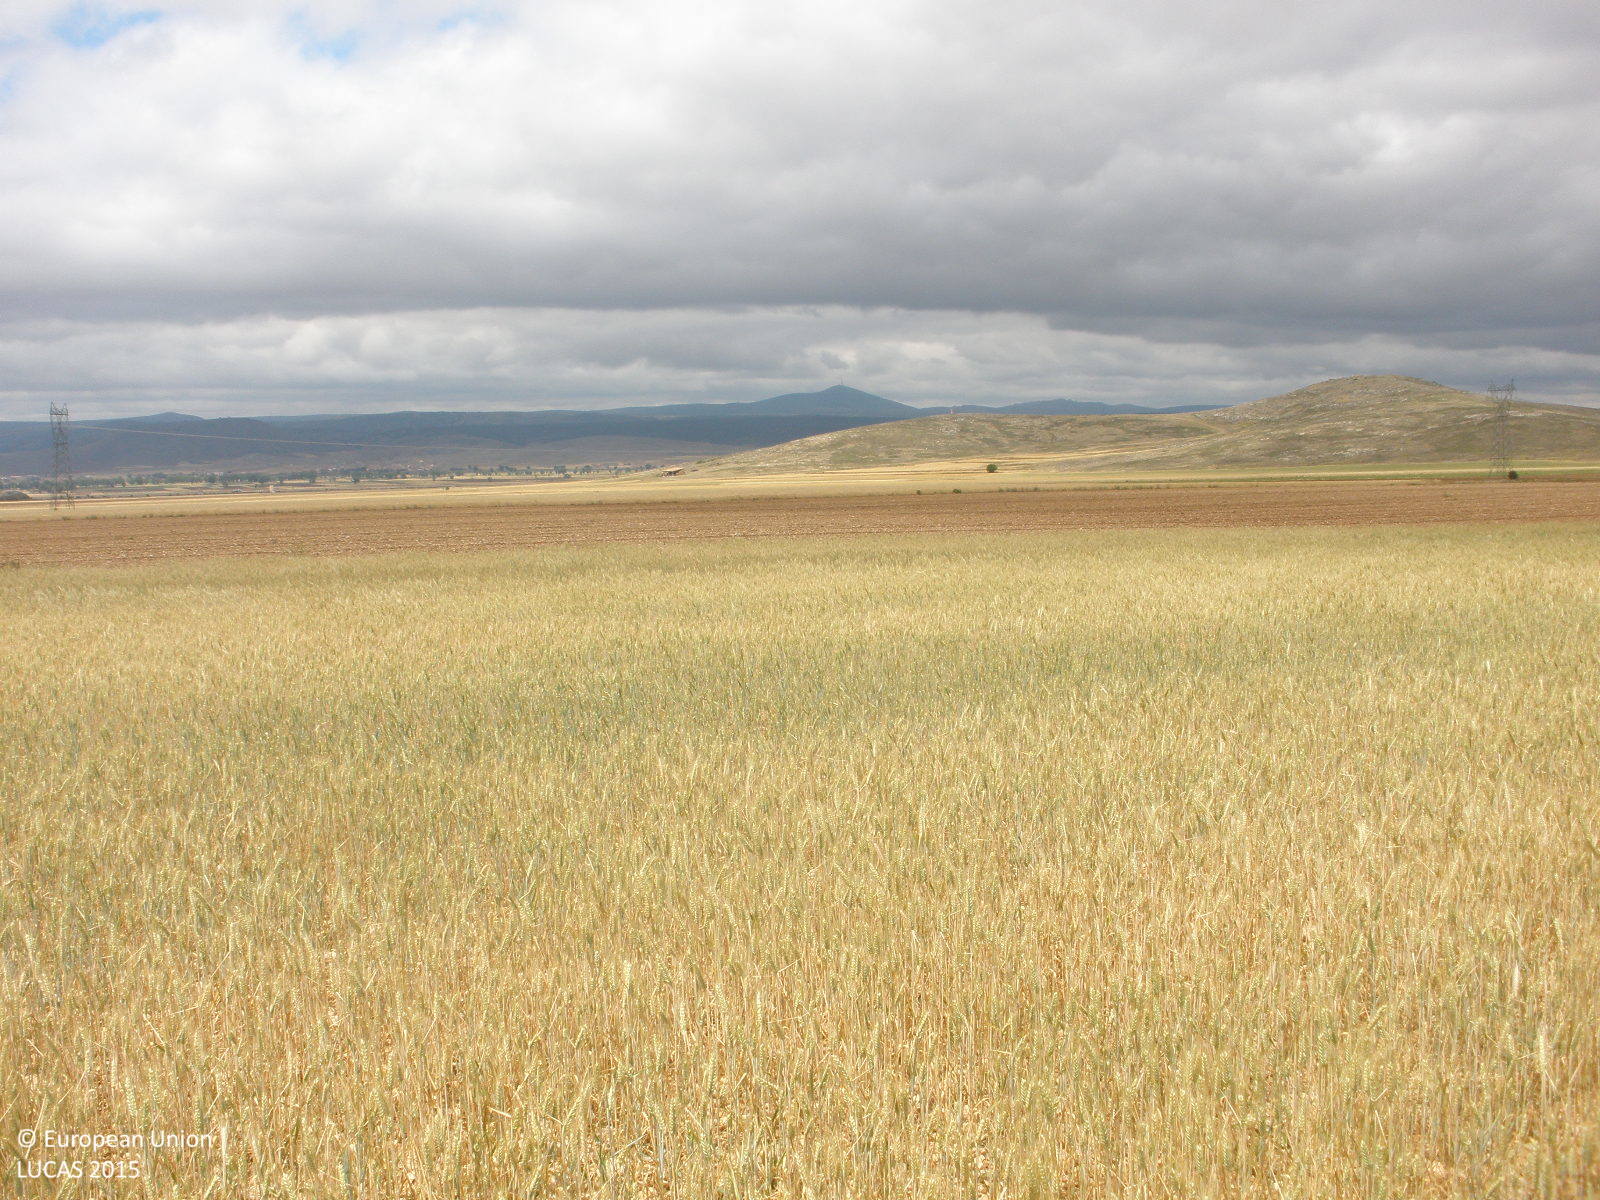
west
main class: Cropland
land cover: Common wheat
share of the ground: > 75 %
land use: Agriculture (excluding fallow land and kitchen gardens)
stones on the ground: > 50 %
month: June
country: ES
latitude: 40.6361
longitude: -1.2829
